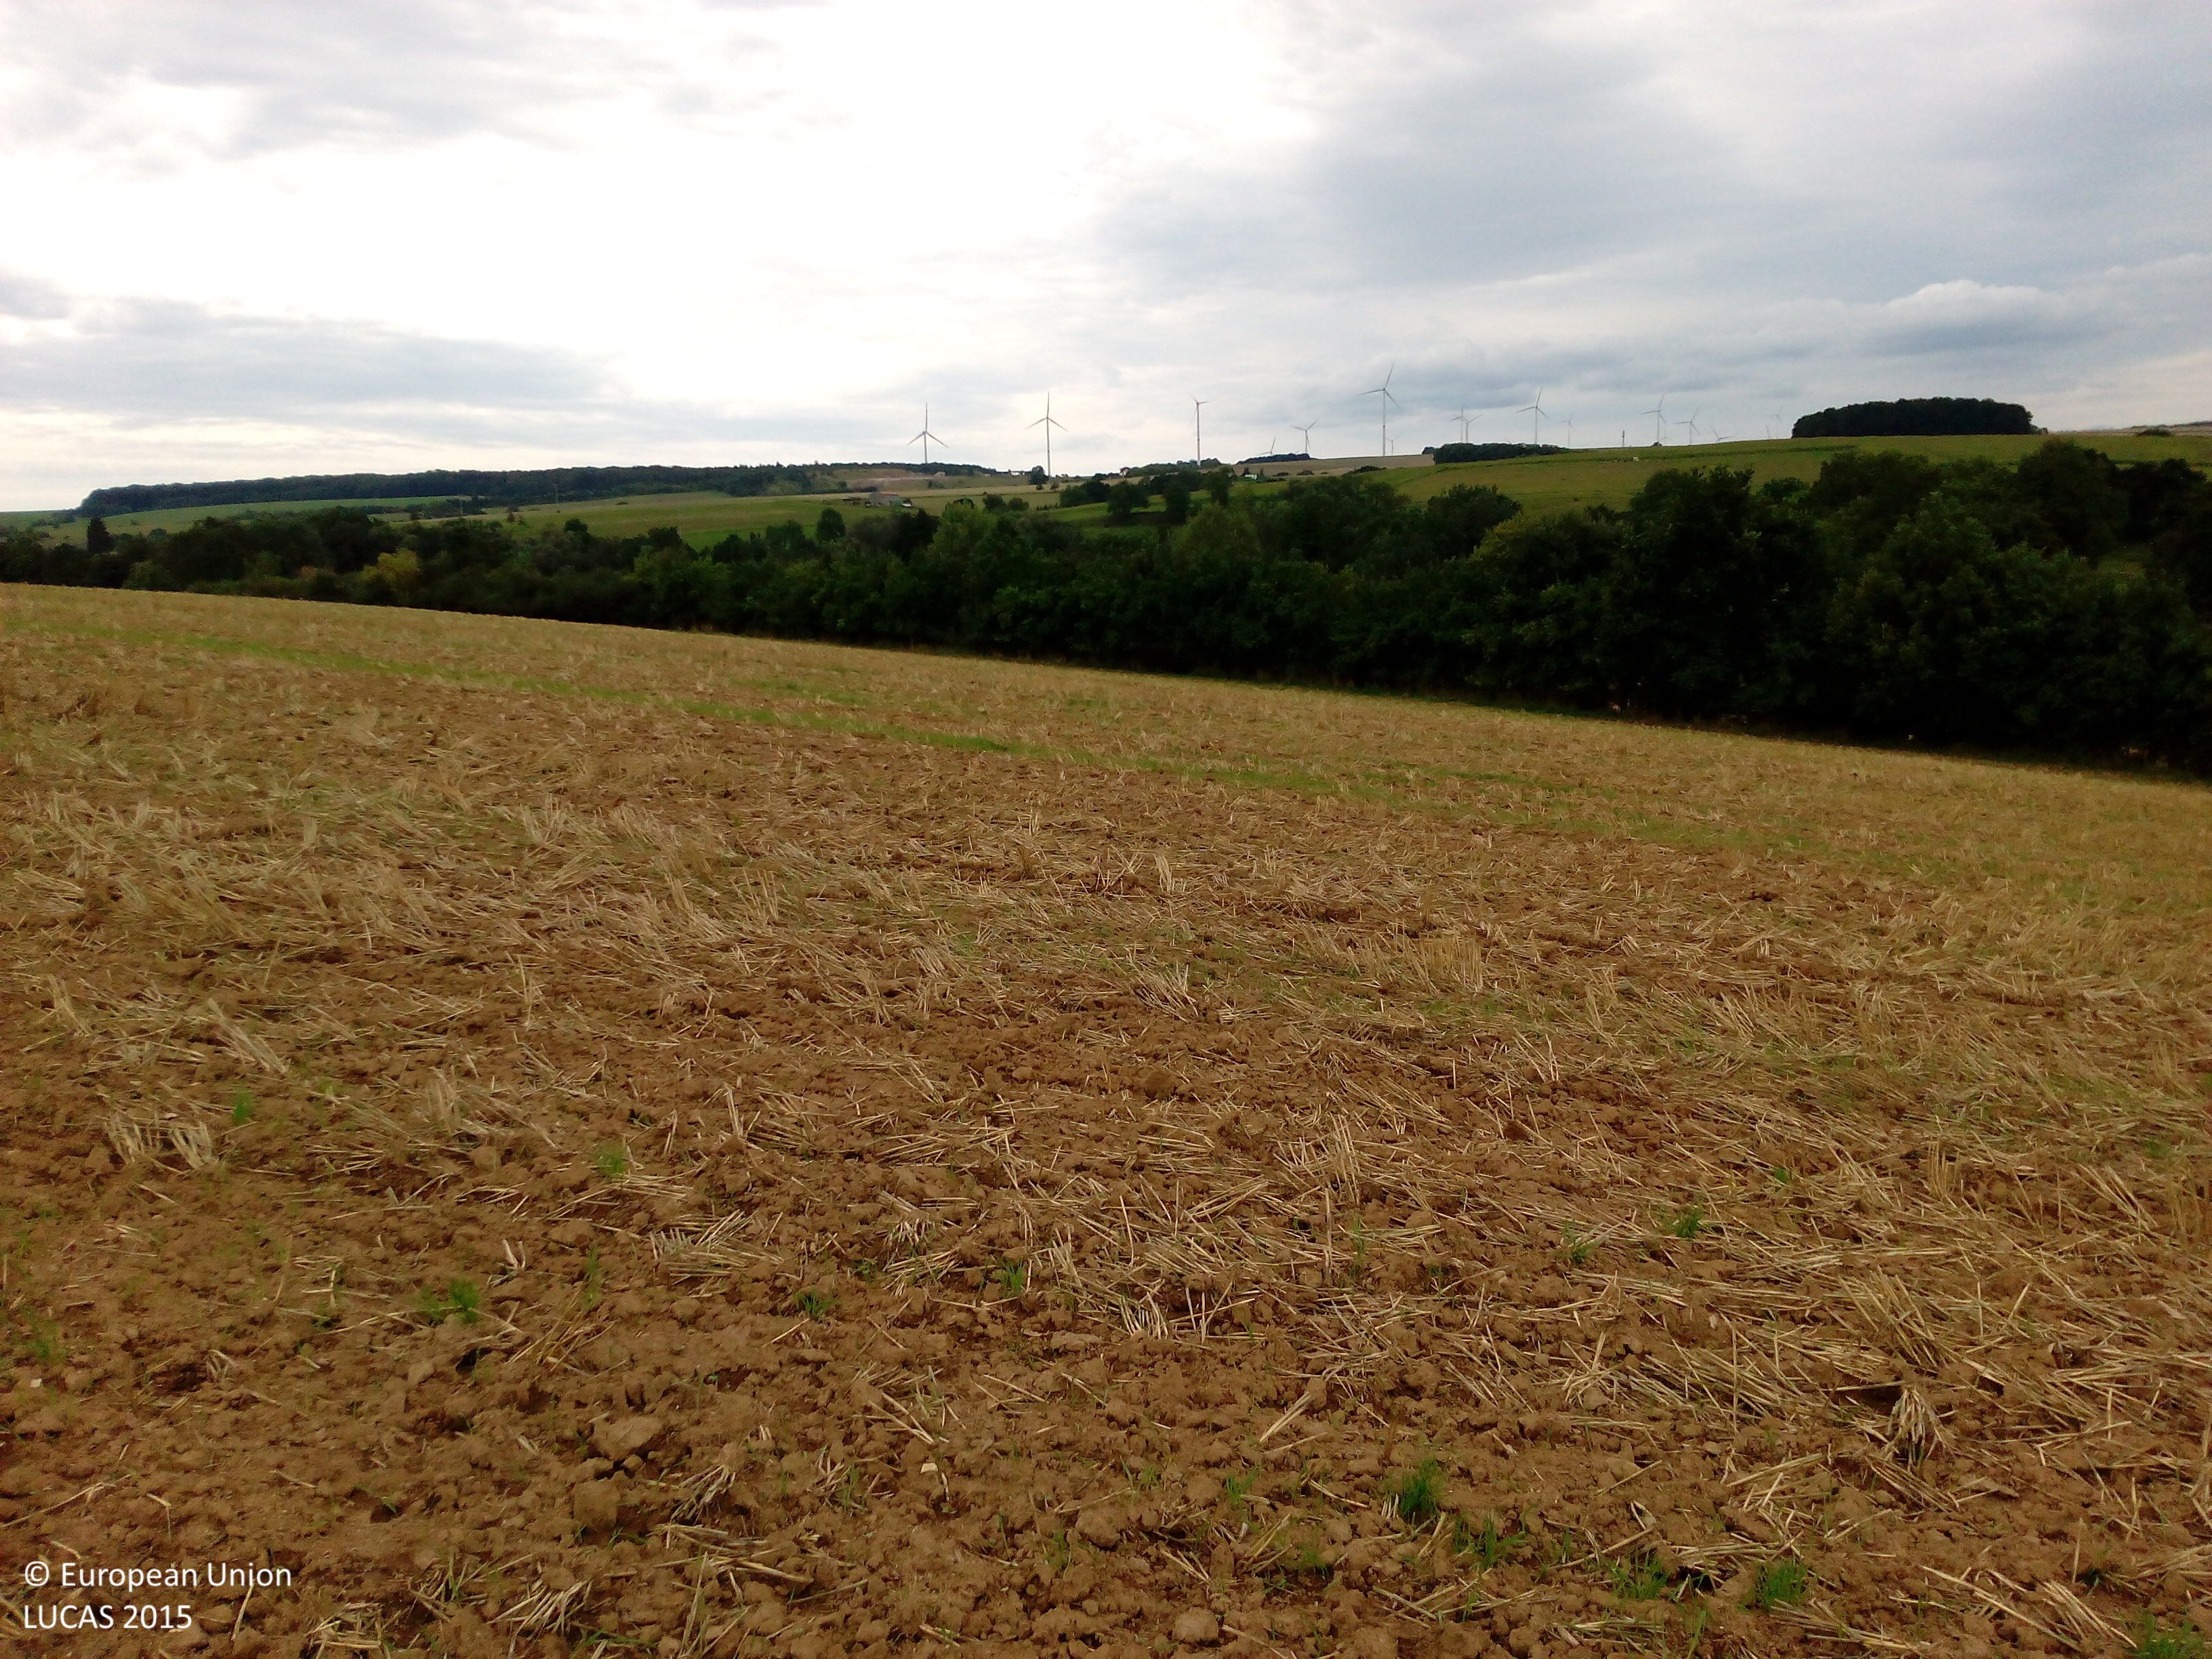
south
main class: Cropland
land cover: Common wheat
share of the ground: 25 - 50 %
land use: Agriculture (excluding fallow land and kitchen gardens)
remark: Harvested field
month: August
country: DE
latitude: 51.0647
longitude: 10.3566
